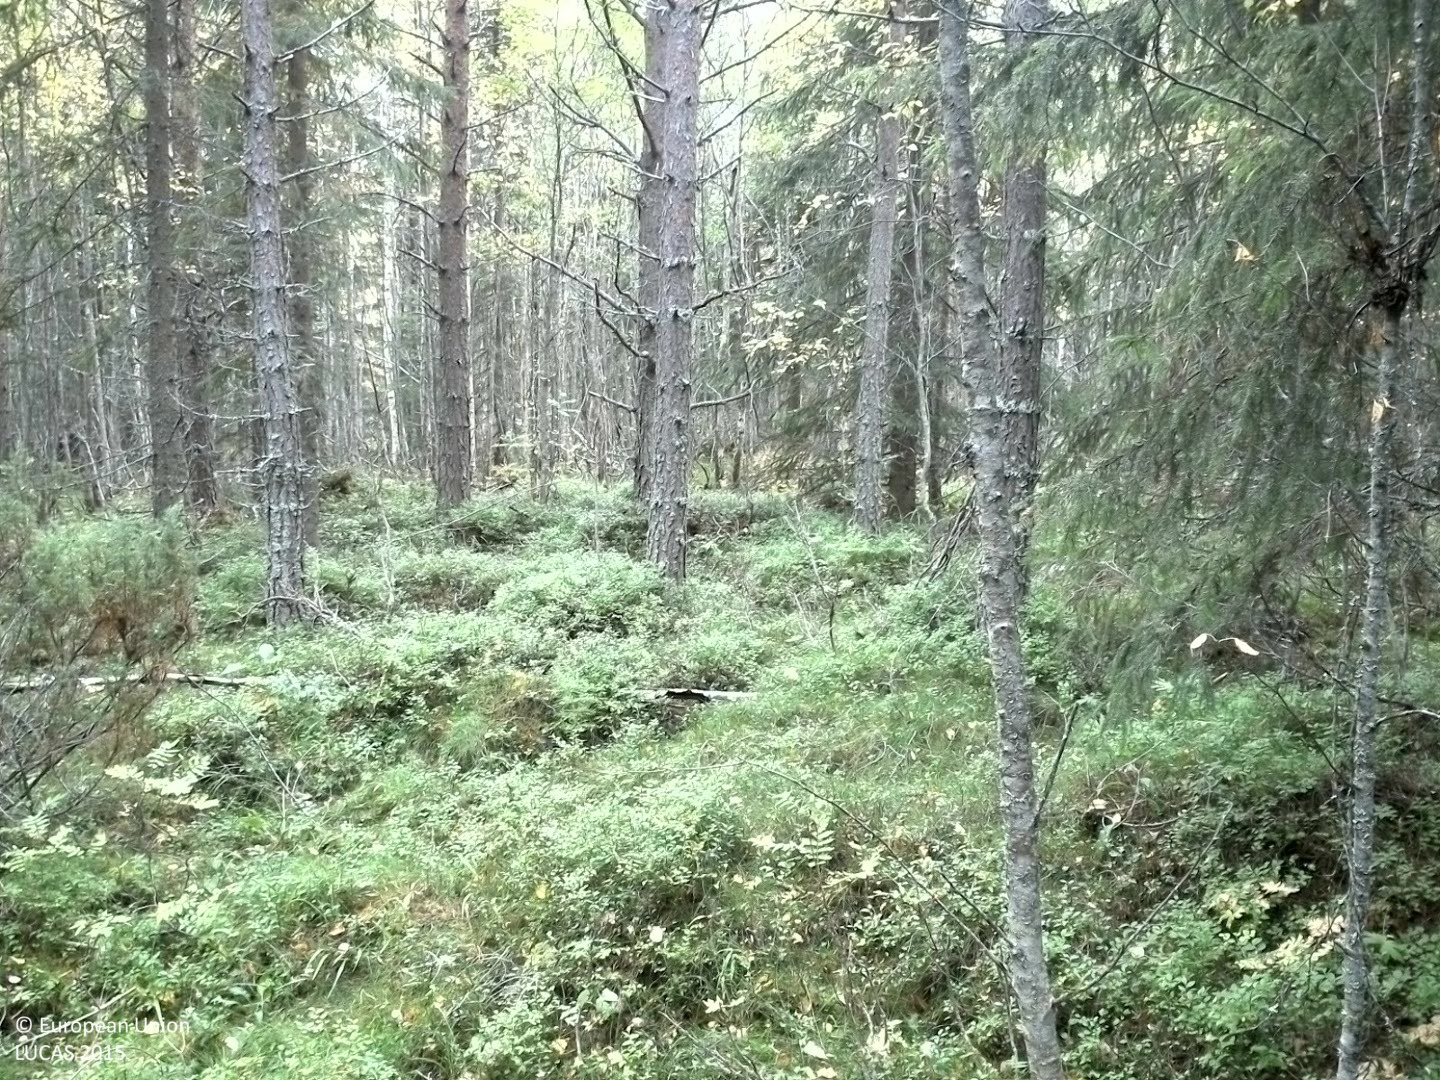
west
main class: Woodland
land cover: Other mixed woodland
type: boreal forest
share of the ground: 50 - 75 %
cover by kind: coniferous forest trees 45 %, herbaceous plants 25 %, broadleaved forest trees 20 %, shrubs 10 %
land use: Forestry
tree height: > 5 m
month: September
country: SE
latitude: 62.3082
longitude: 15.6321
